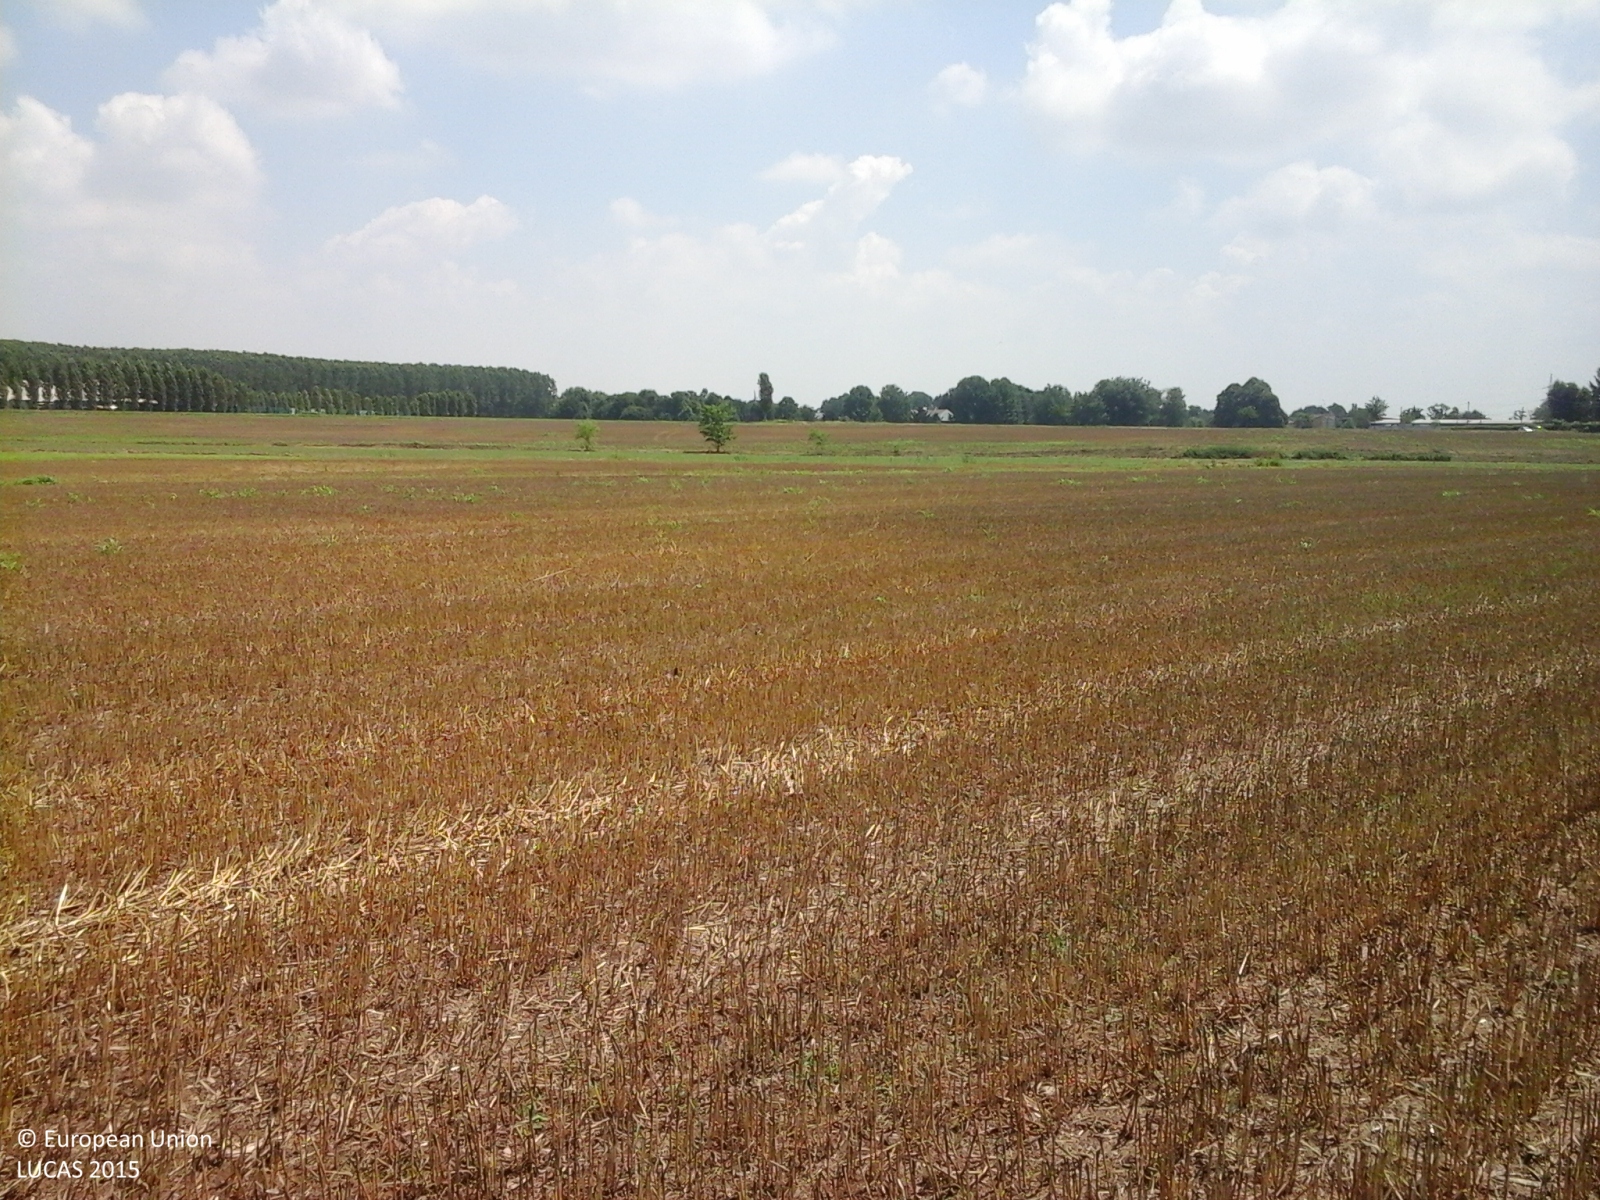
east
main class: Cropland
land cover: Common wheat
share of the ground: < 10 %
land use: Agriculture (excluding fallow land and kitchen gardens)
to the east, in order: Common wheat; Grass margins; Ditches and canals; Grass margins; Common wheat; Grass margins; Ditches and canals; Grass margins; Soya; Spontaneously vegetated surfaces; Inland fresh running water; Spontaneously vegetated surfaces; Common wheat
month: June
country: IT
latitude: 45.4617
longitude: 8.8126
